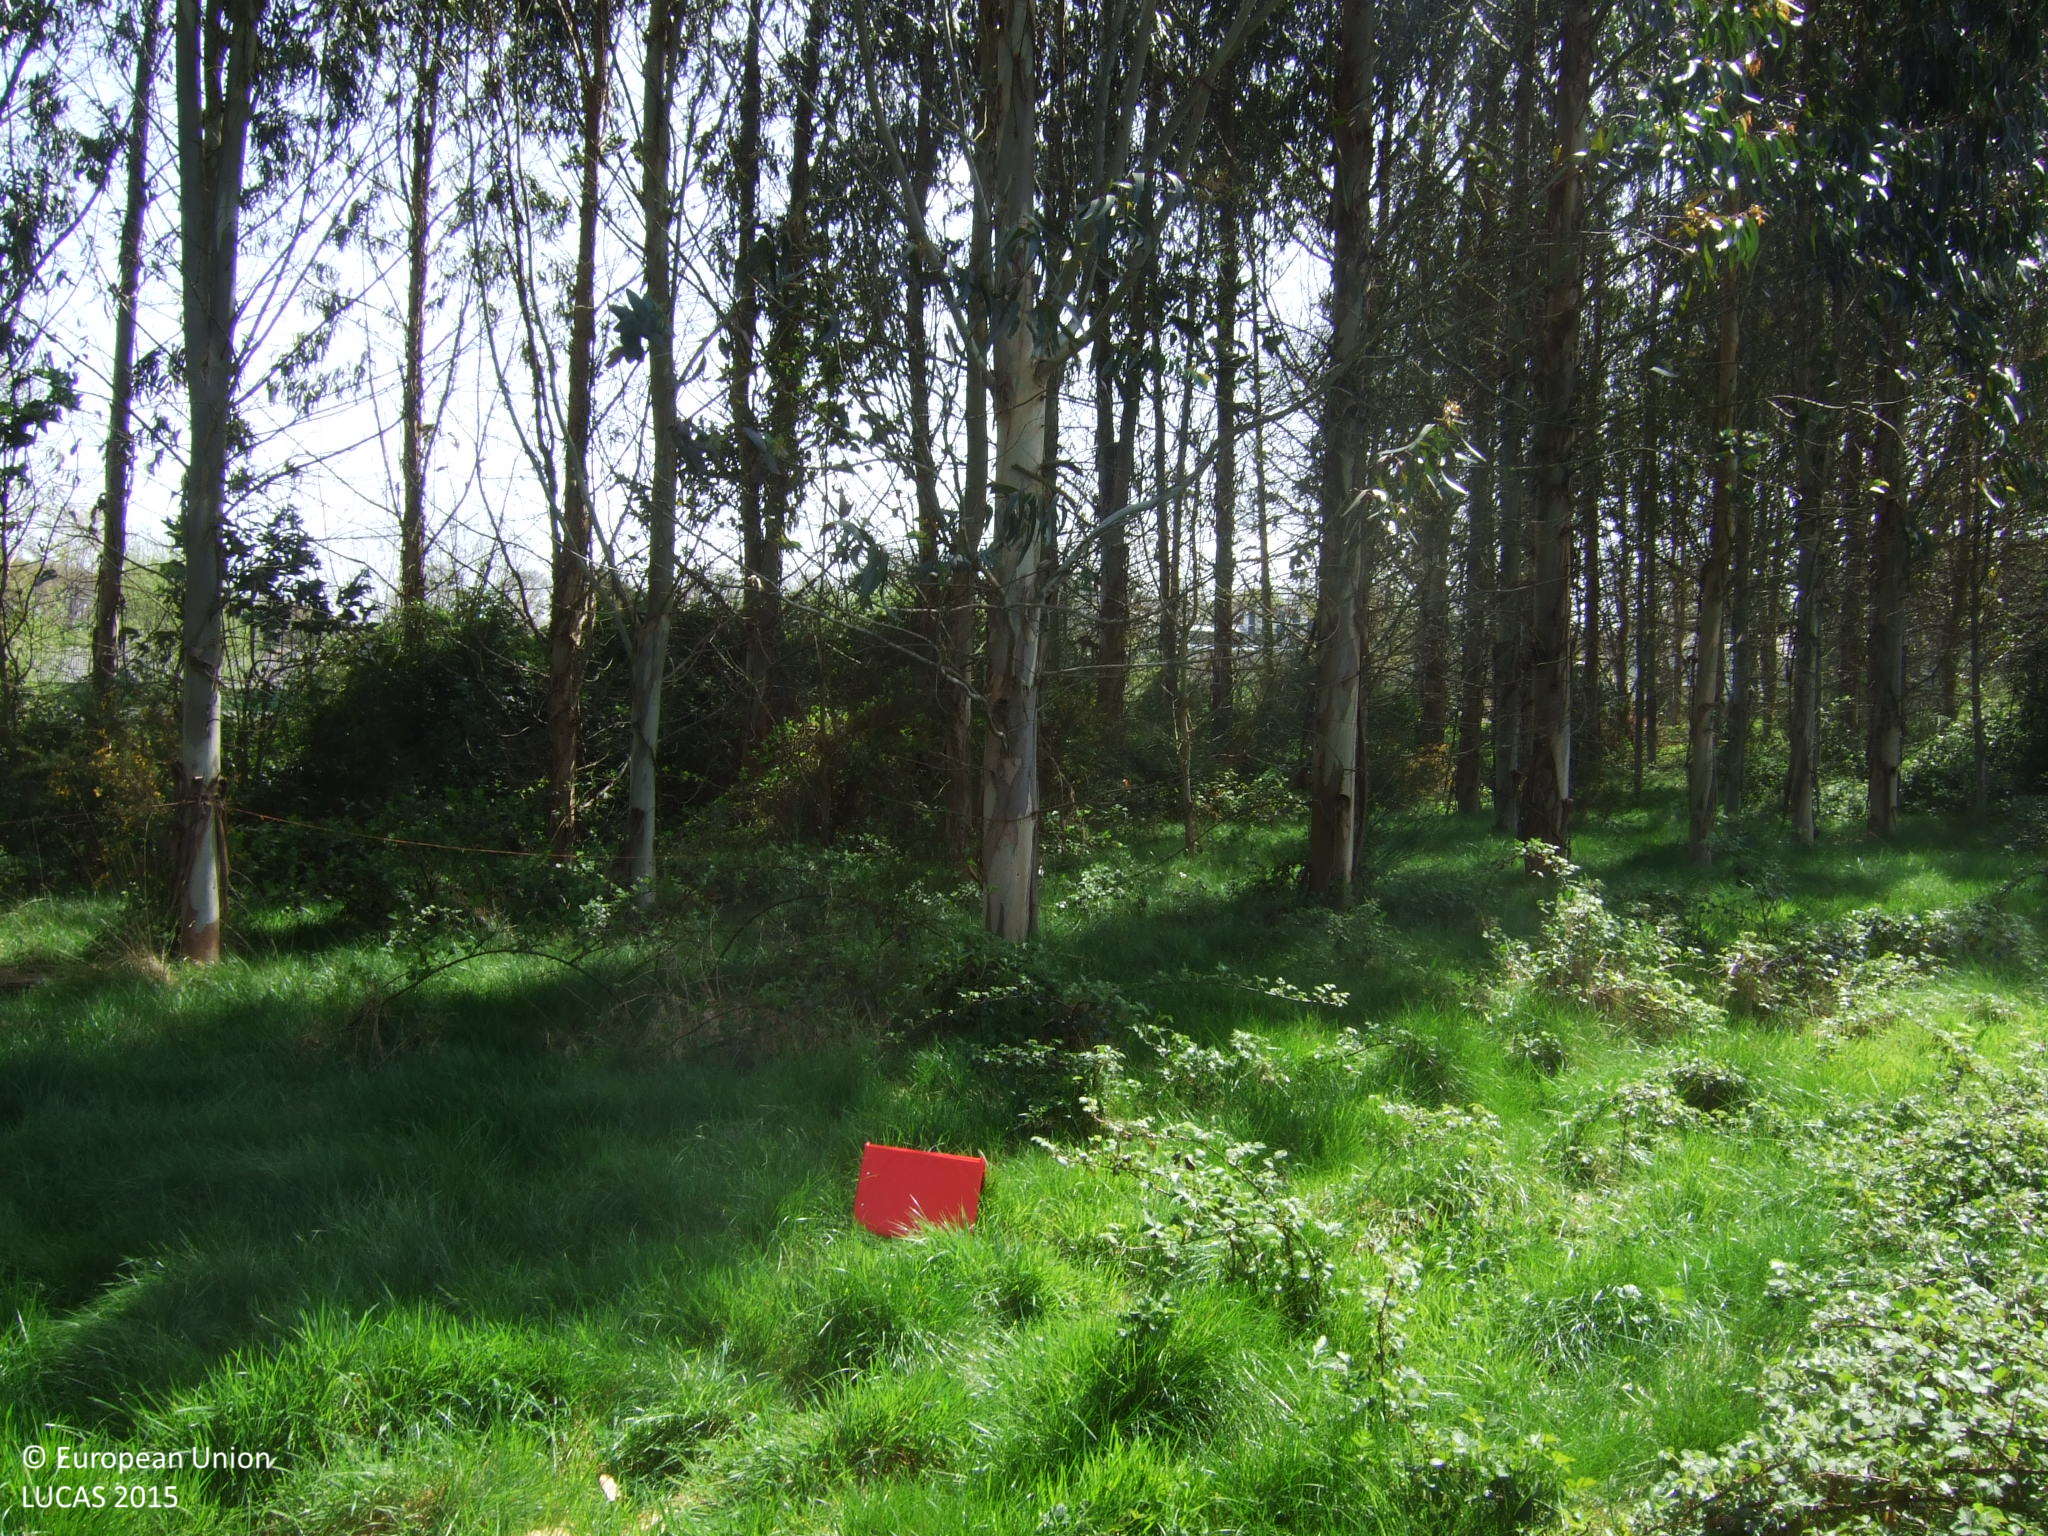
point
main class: Woodland
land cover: Broadleaved woodland
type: acidophilous oak and oak-birch forest
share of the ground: 50 - 75 %
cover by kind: broadleaved forest trees 65 %, shrubs 35 %
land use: Forestry
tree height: > 5 m
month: April
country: ES
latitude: 42.9572
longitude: -7.6198
